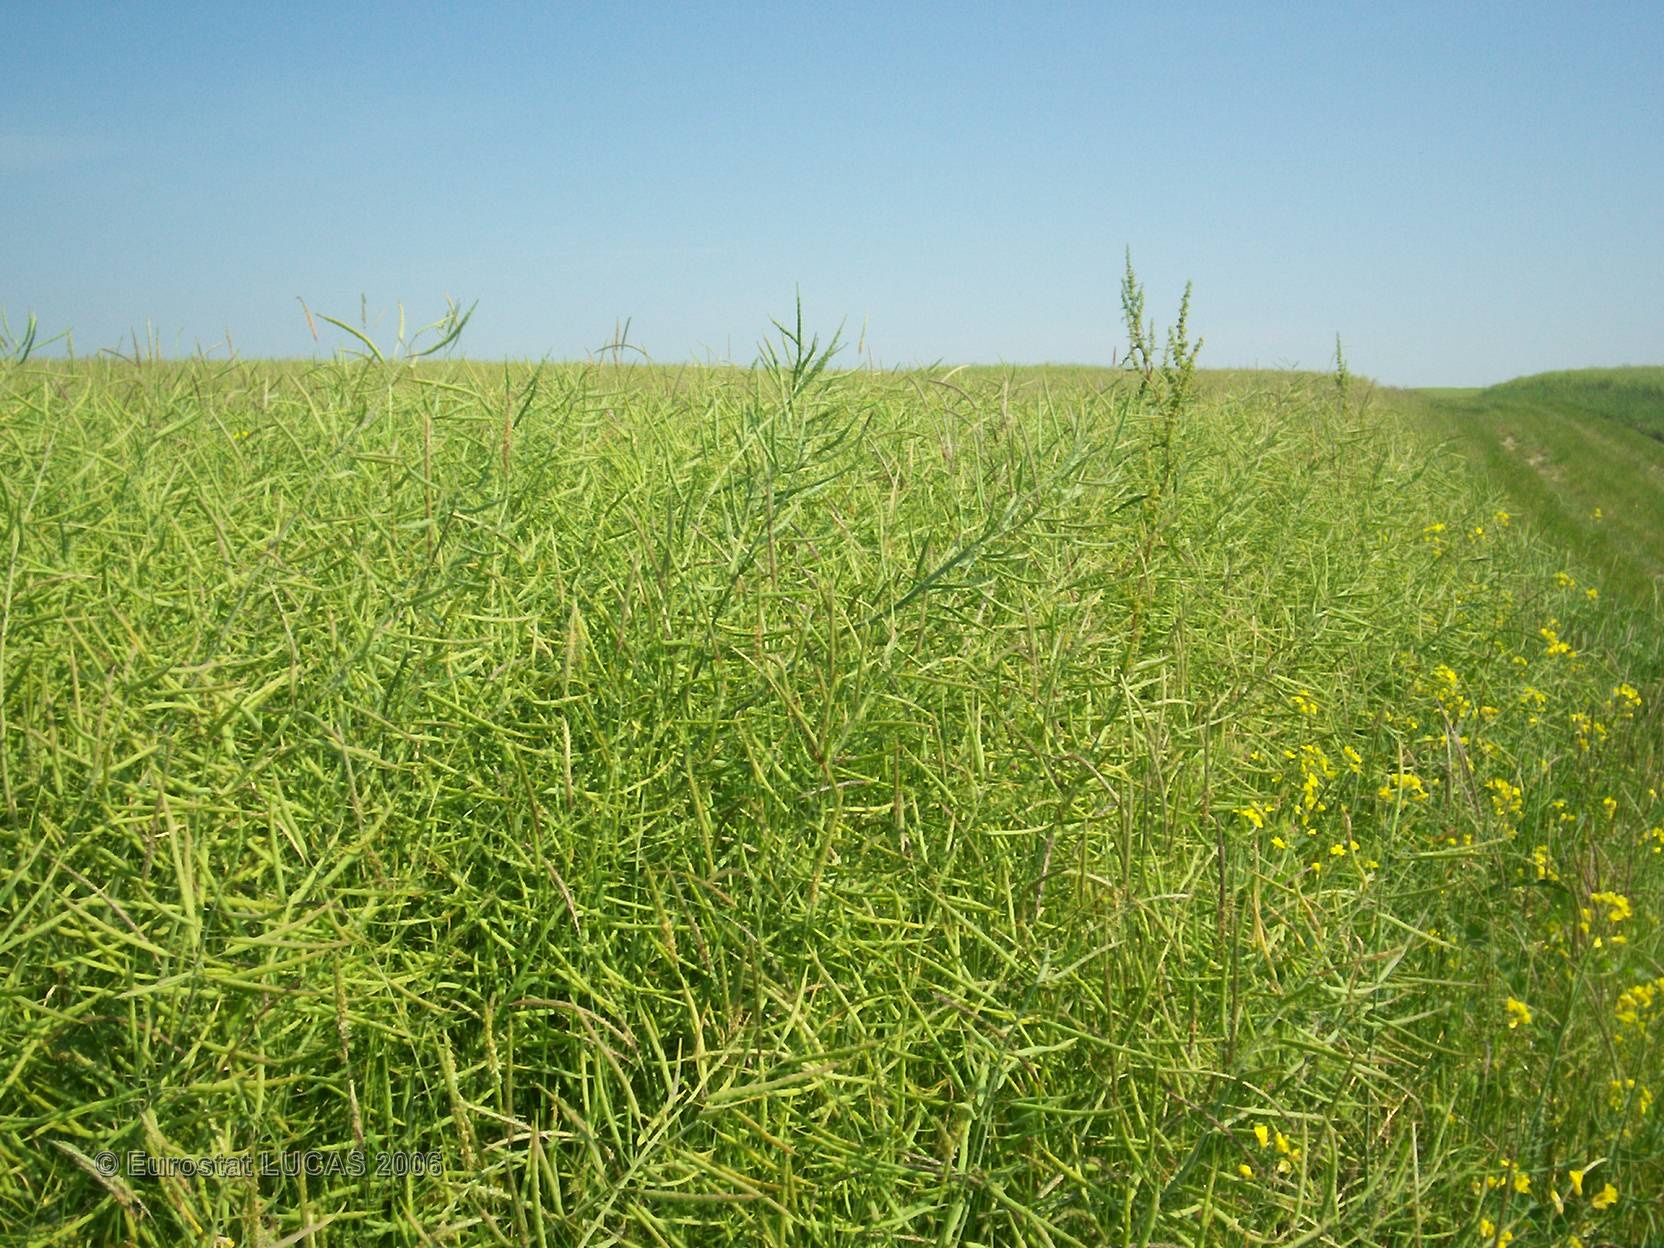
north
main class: Cropland
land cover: Rape and turnip rape
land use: Agriculture (excluding fallow land and kitchen gardens)
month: June
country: FR
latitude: 49.0389
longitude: 4.8129
